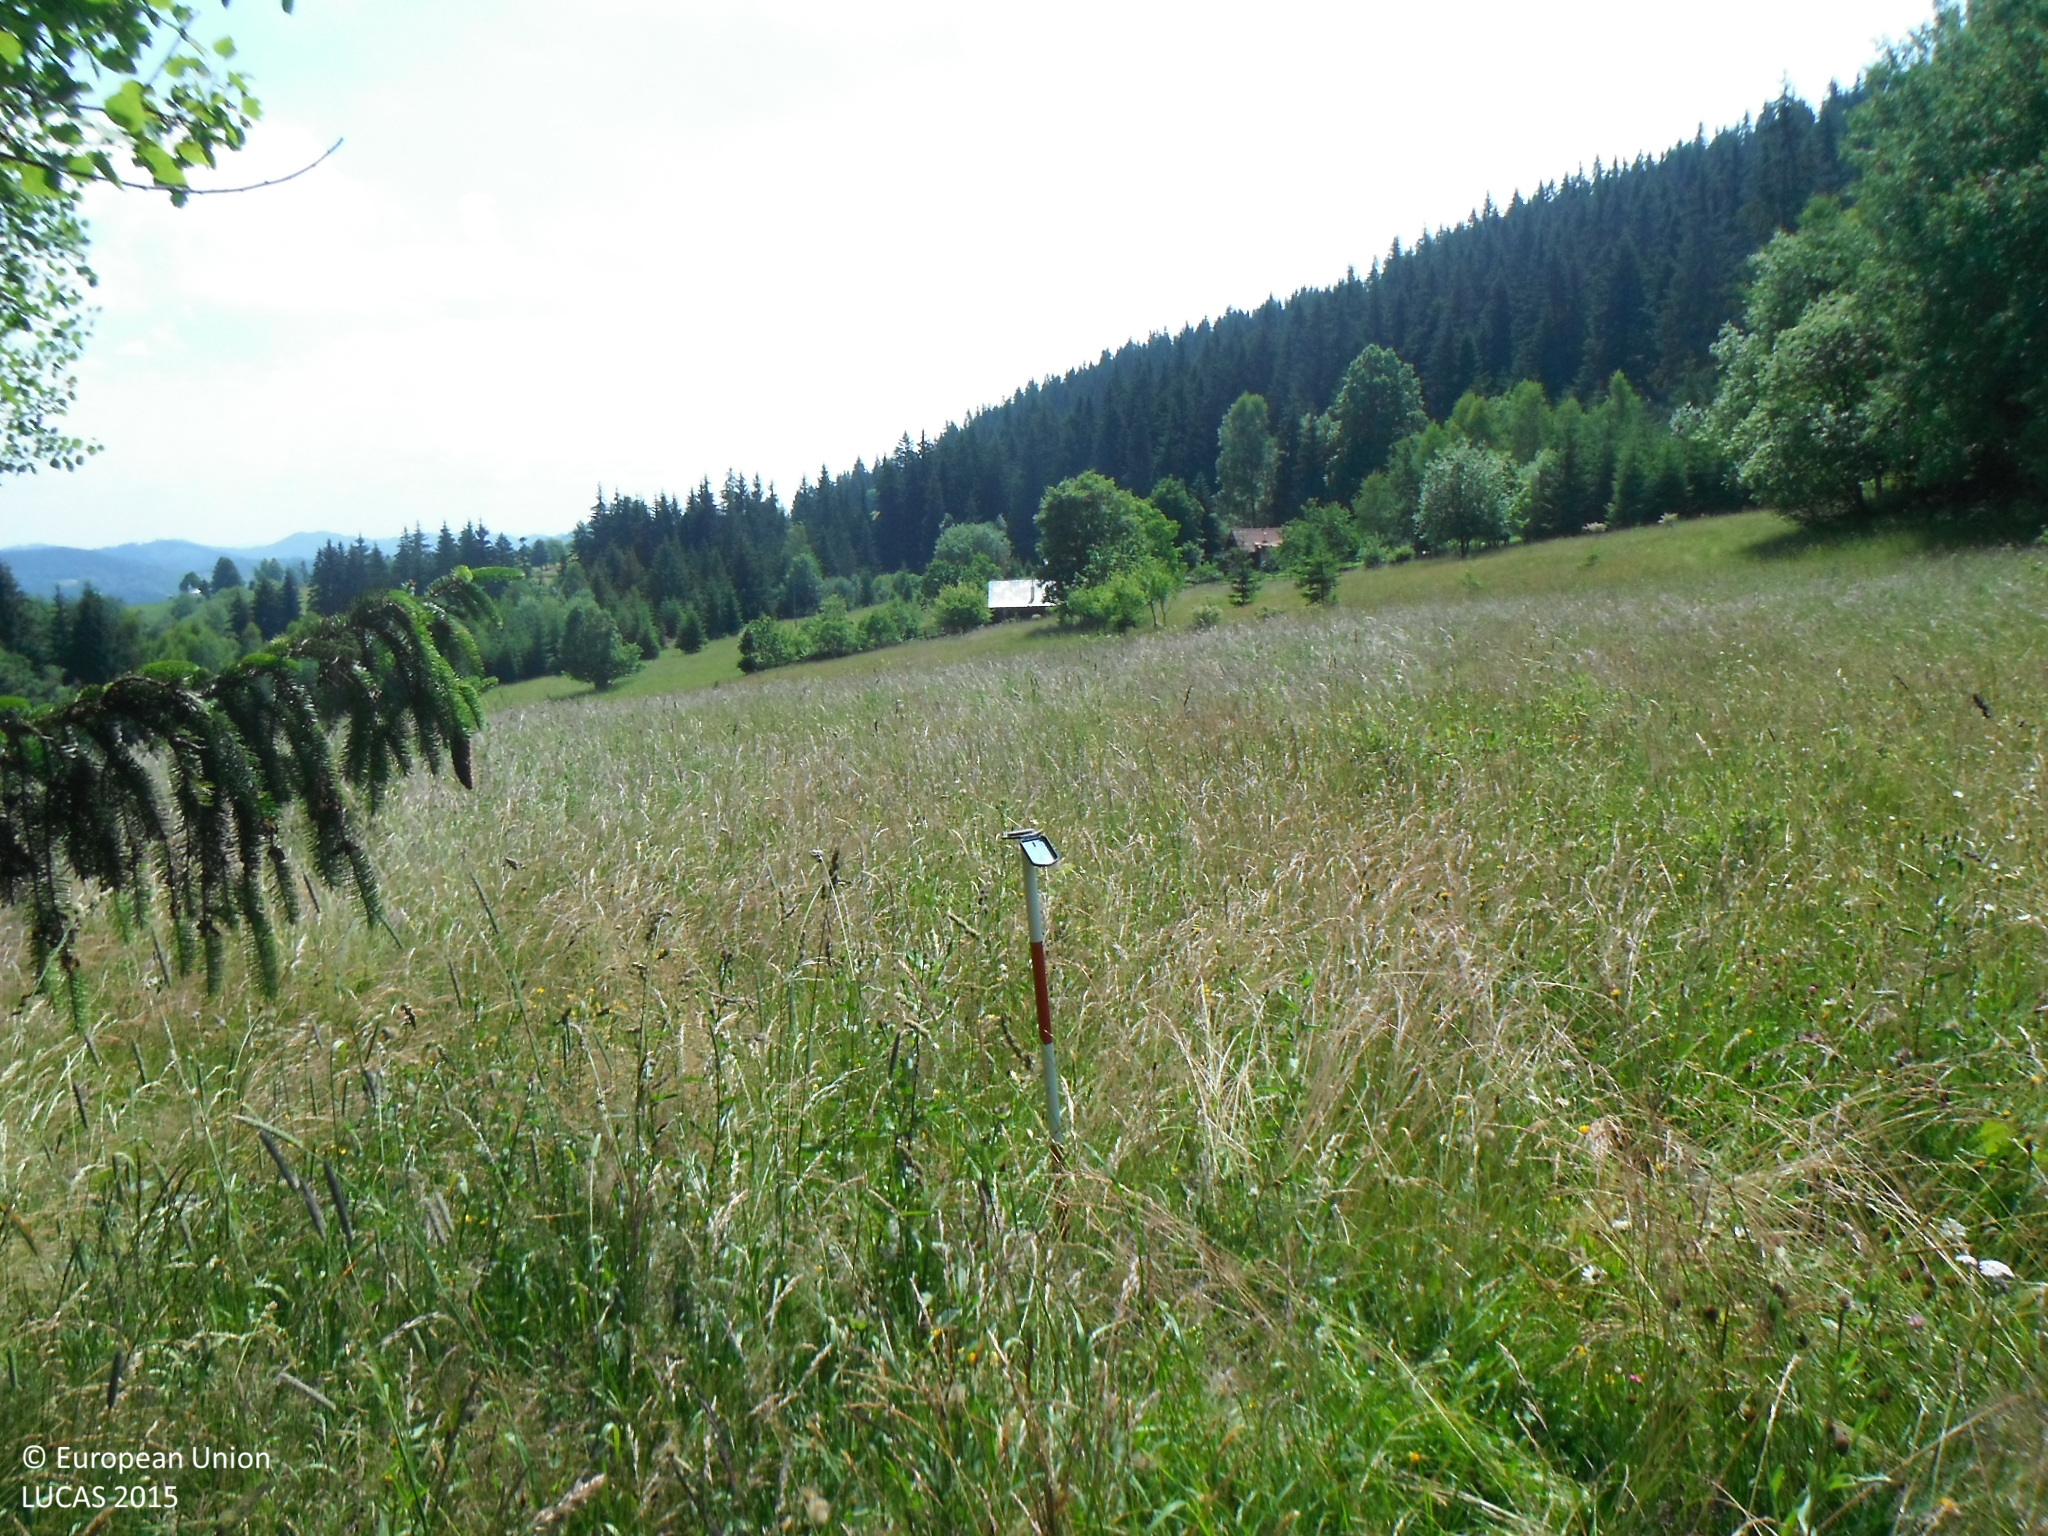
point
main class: Grassland
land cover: Grassland without tree/shrub cover
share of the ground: > 75 %
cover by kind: herbaceous plants 95 %, shrubs 5 %
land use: Agriculture (excluding fallow land and kitchen gardens)
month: July
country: SK
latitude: 49.3412
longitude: 18.5103
